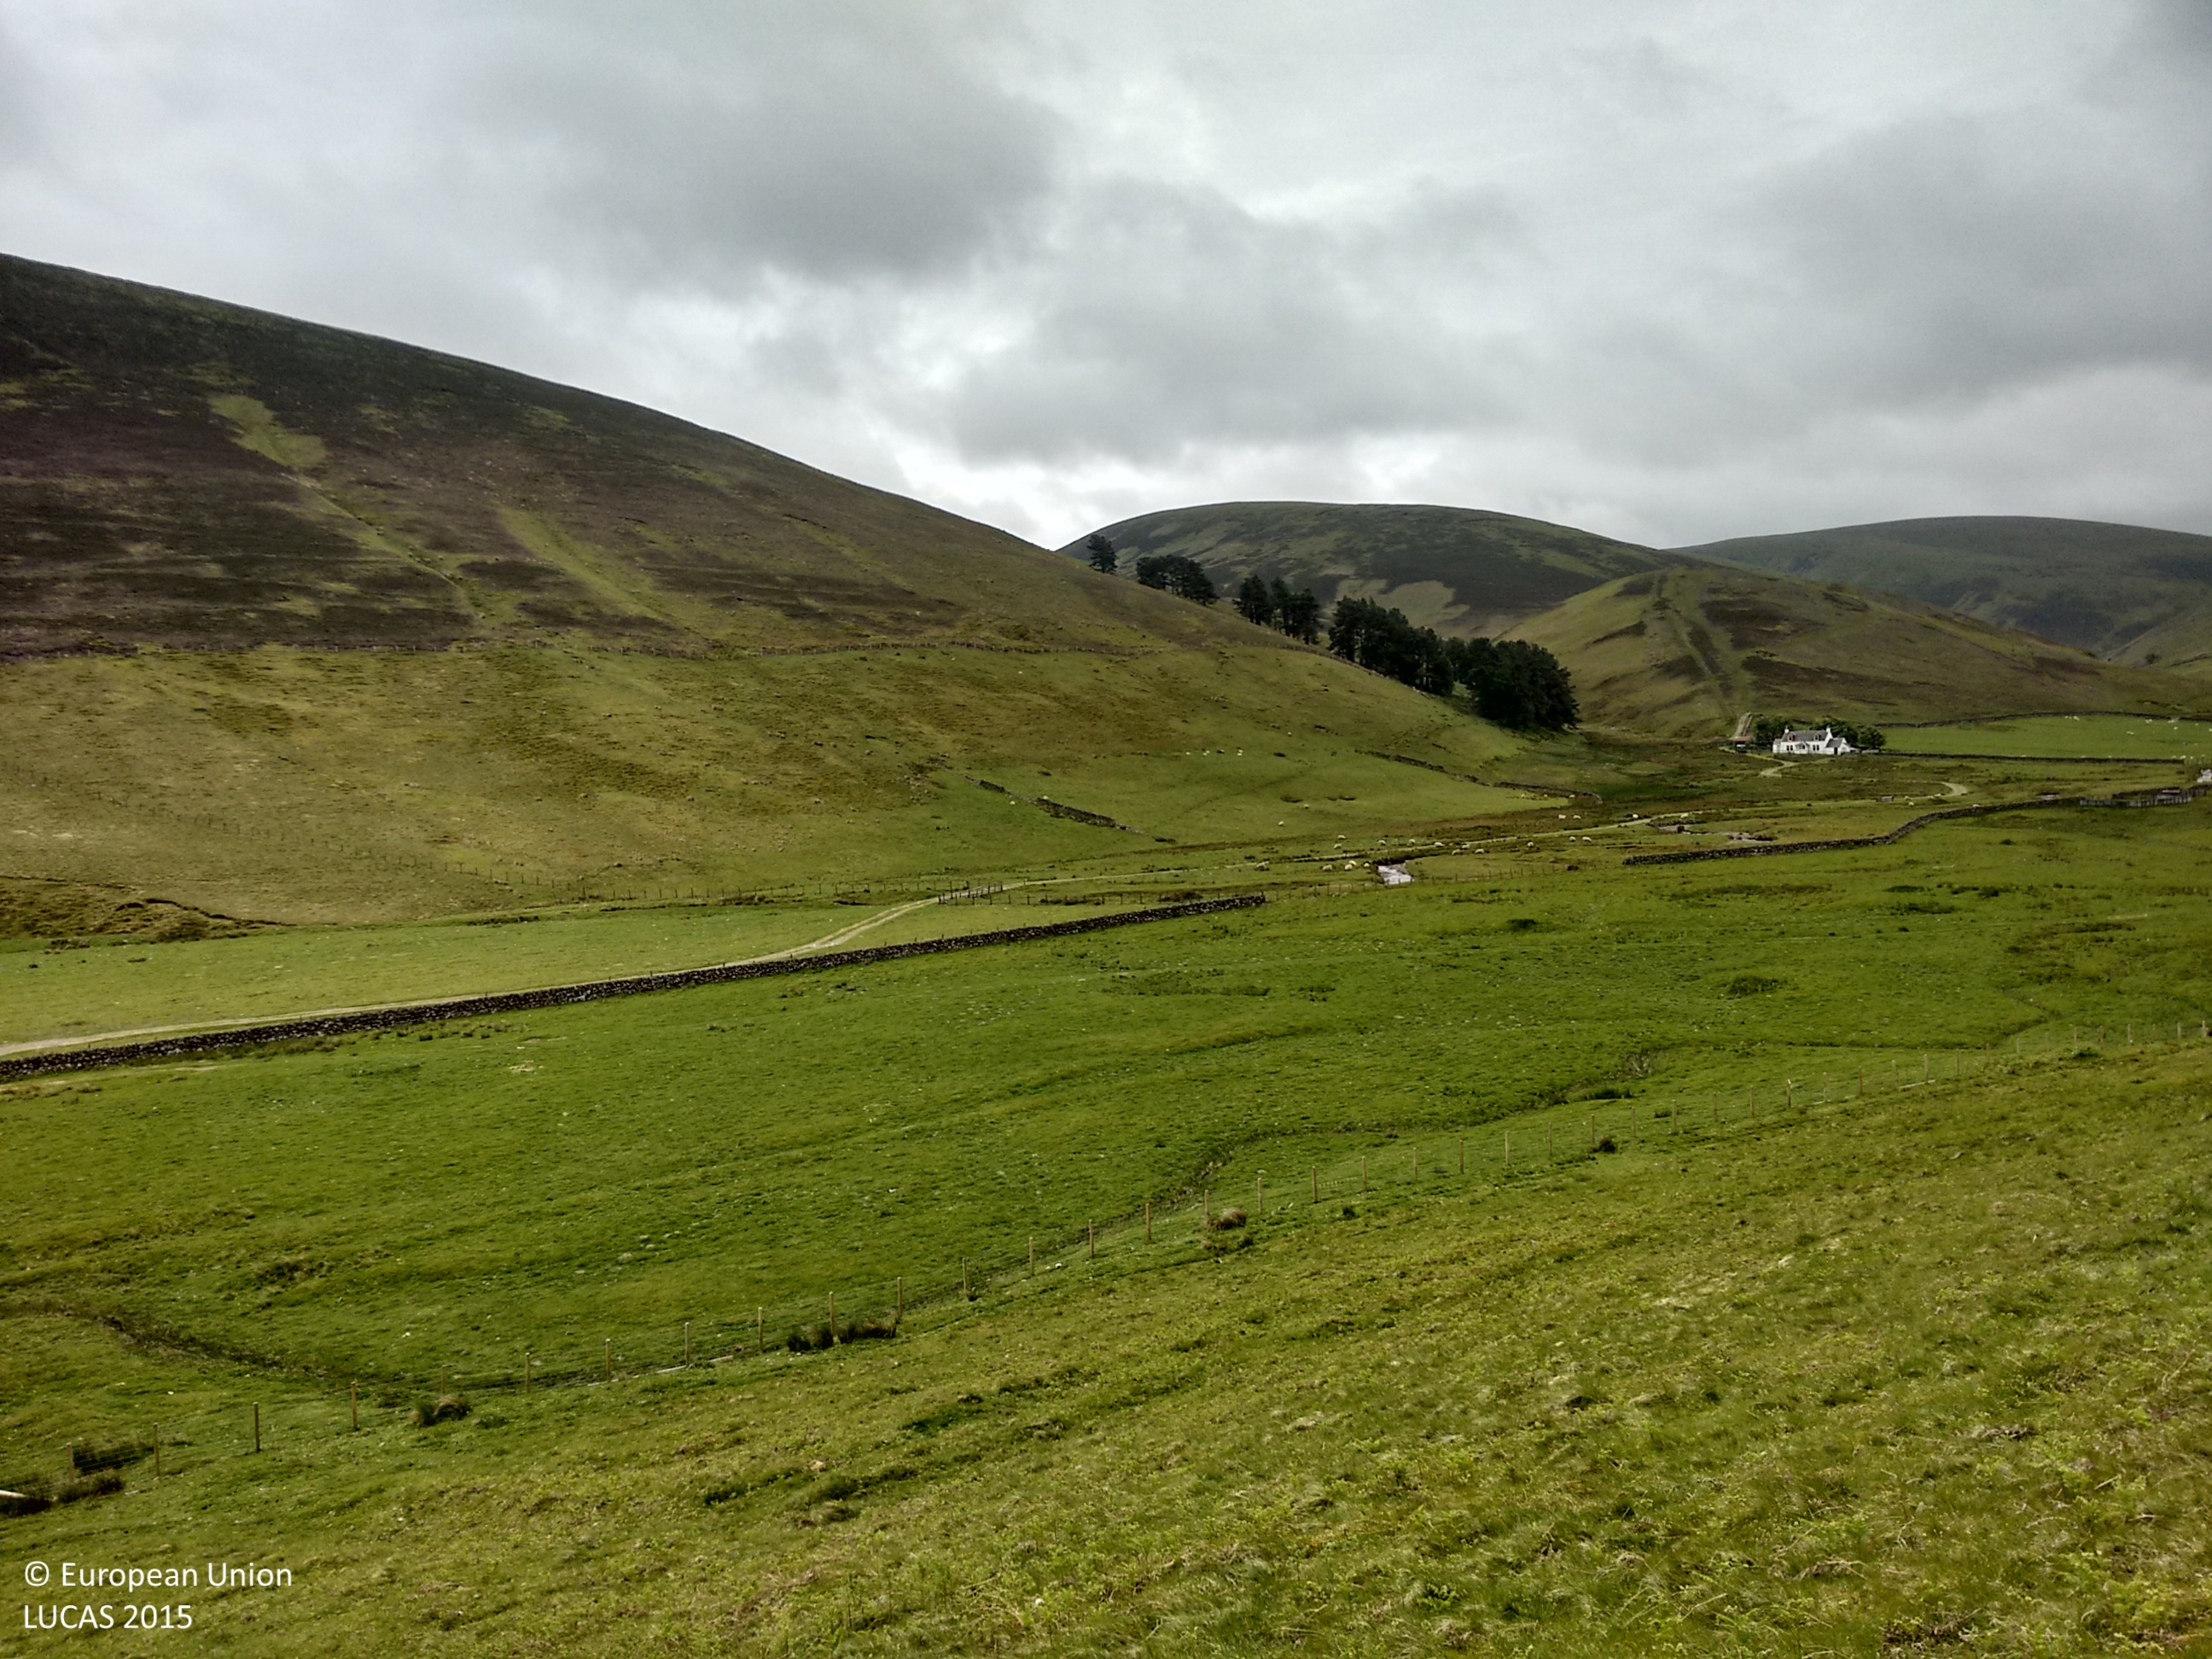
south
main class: Grassland
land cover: Grassland without tree/shrub cover
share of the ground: > 75 %
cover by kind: herbaceous plants 100 %
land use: Agriculture (excluding fallow land and kitchen gardens)
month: June
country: GB
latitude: 55.5461
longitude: -3.4709
